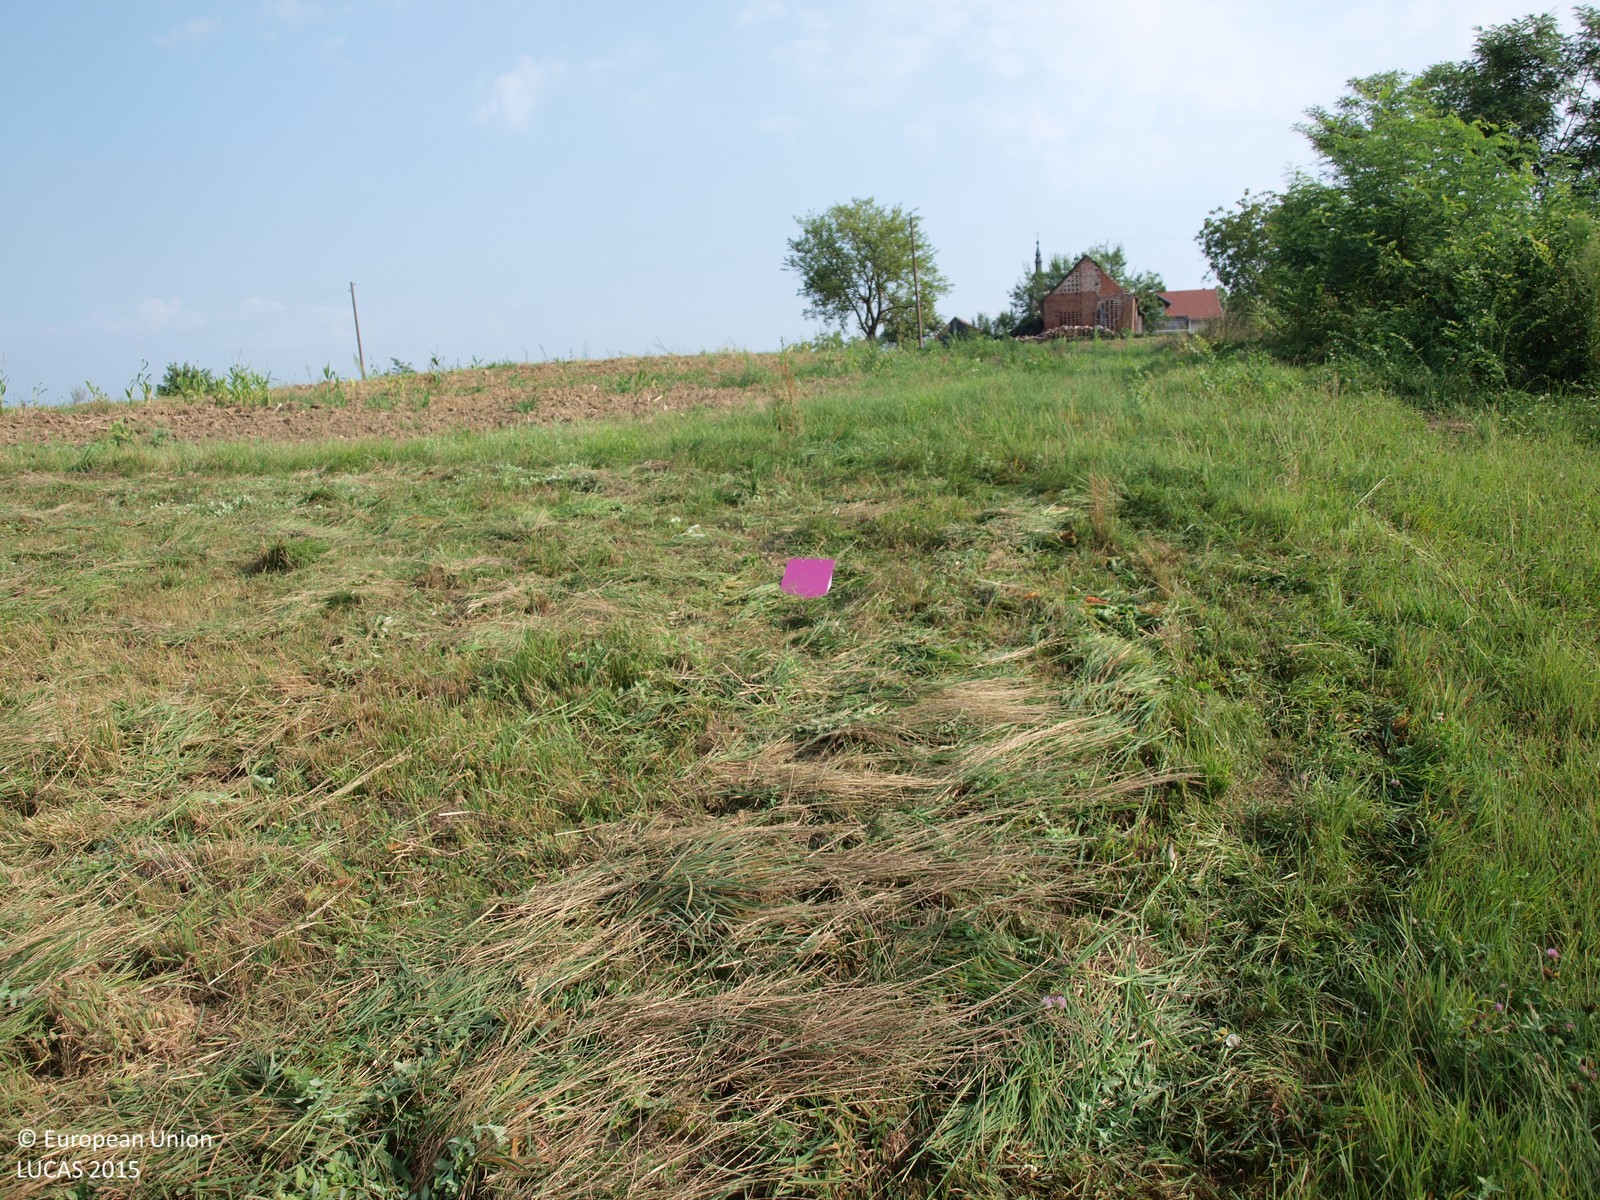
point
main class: Grassland
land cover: Grassland without tree/shrub cover
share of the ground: > 75 %
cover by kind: herbaceous plants 100 %
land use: Agriculture (excluding fallow land and kitchen gardens)
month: August
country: HR
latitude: 45.9436
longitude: 16.3844
